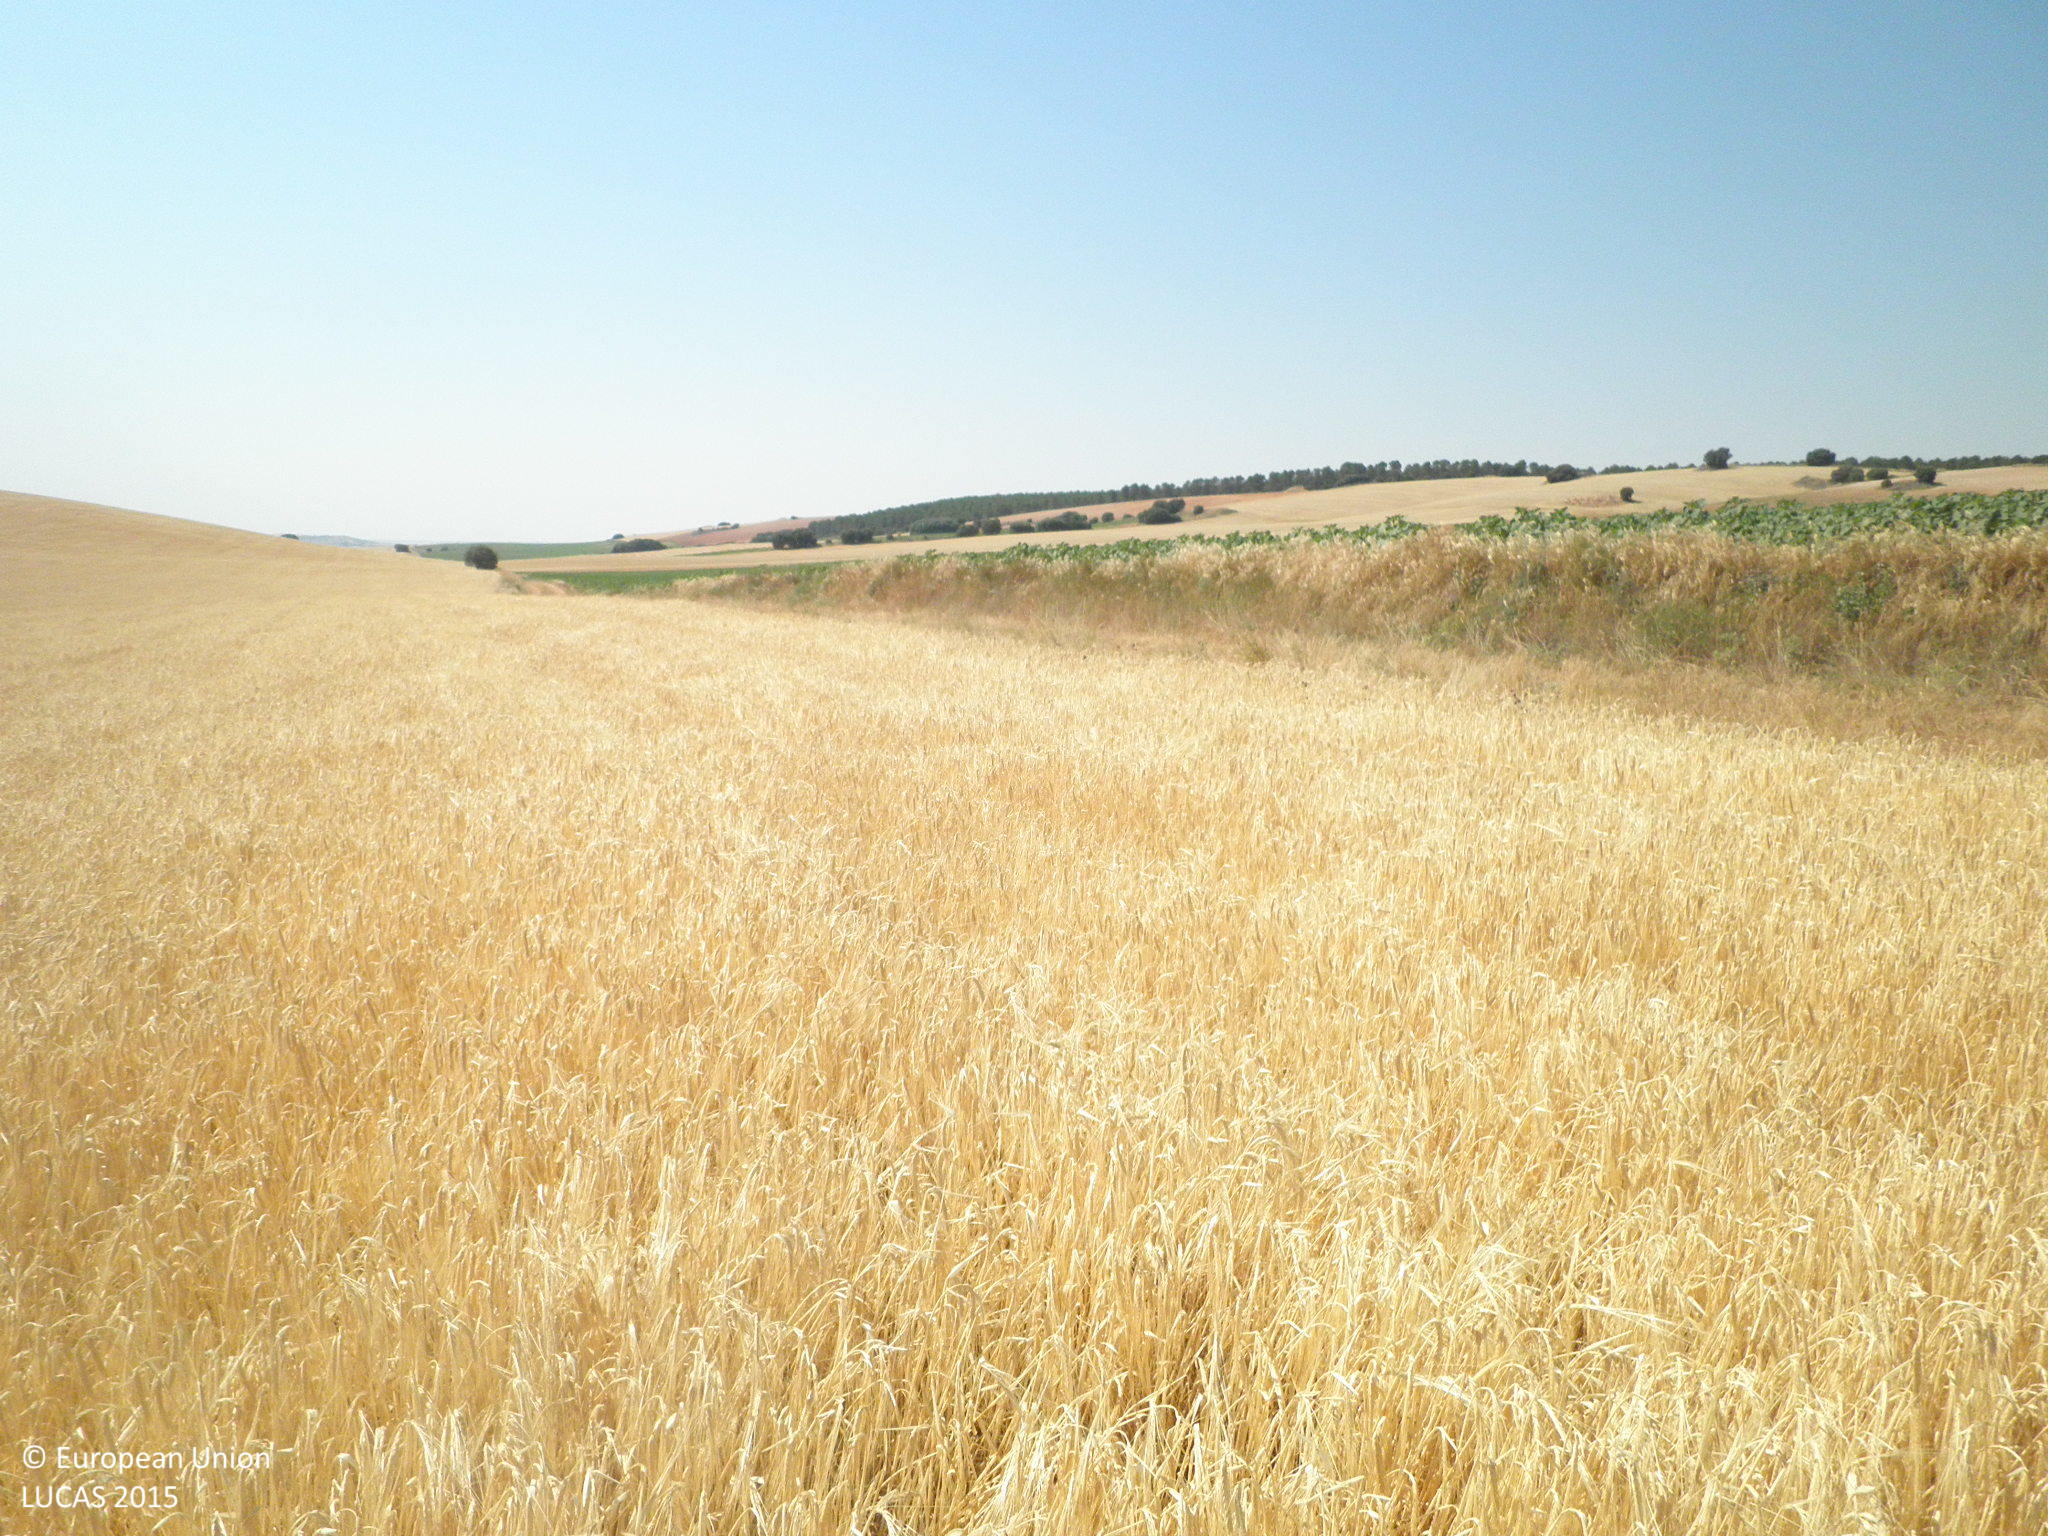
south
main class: Cropland
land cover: Barley
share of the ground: > 75 %
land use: Agriculture (excluding fallow land and kitchen gardens)
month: June
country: ES
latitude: 39.6510
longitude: -2.4721
